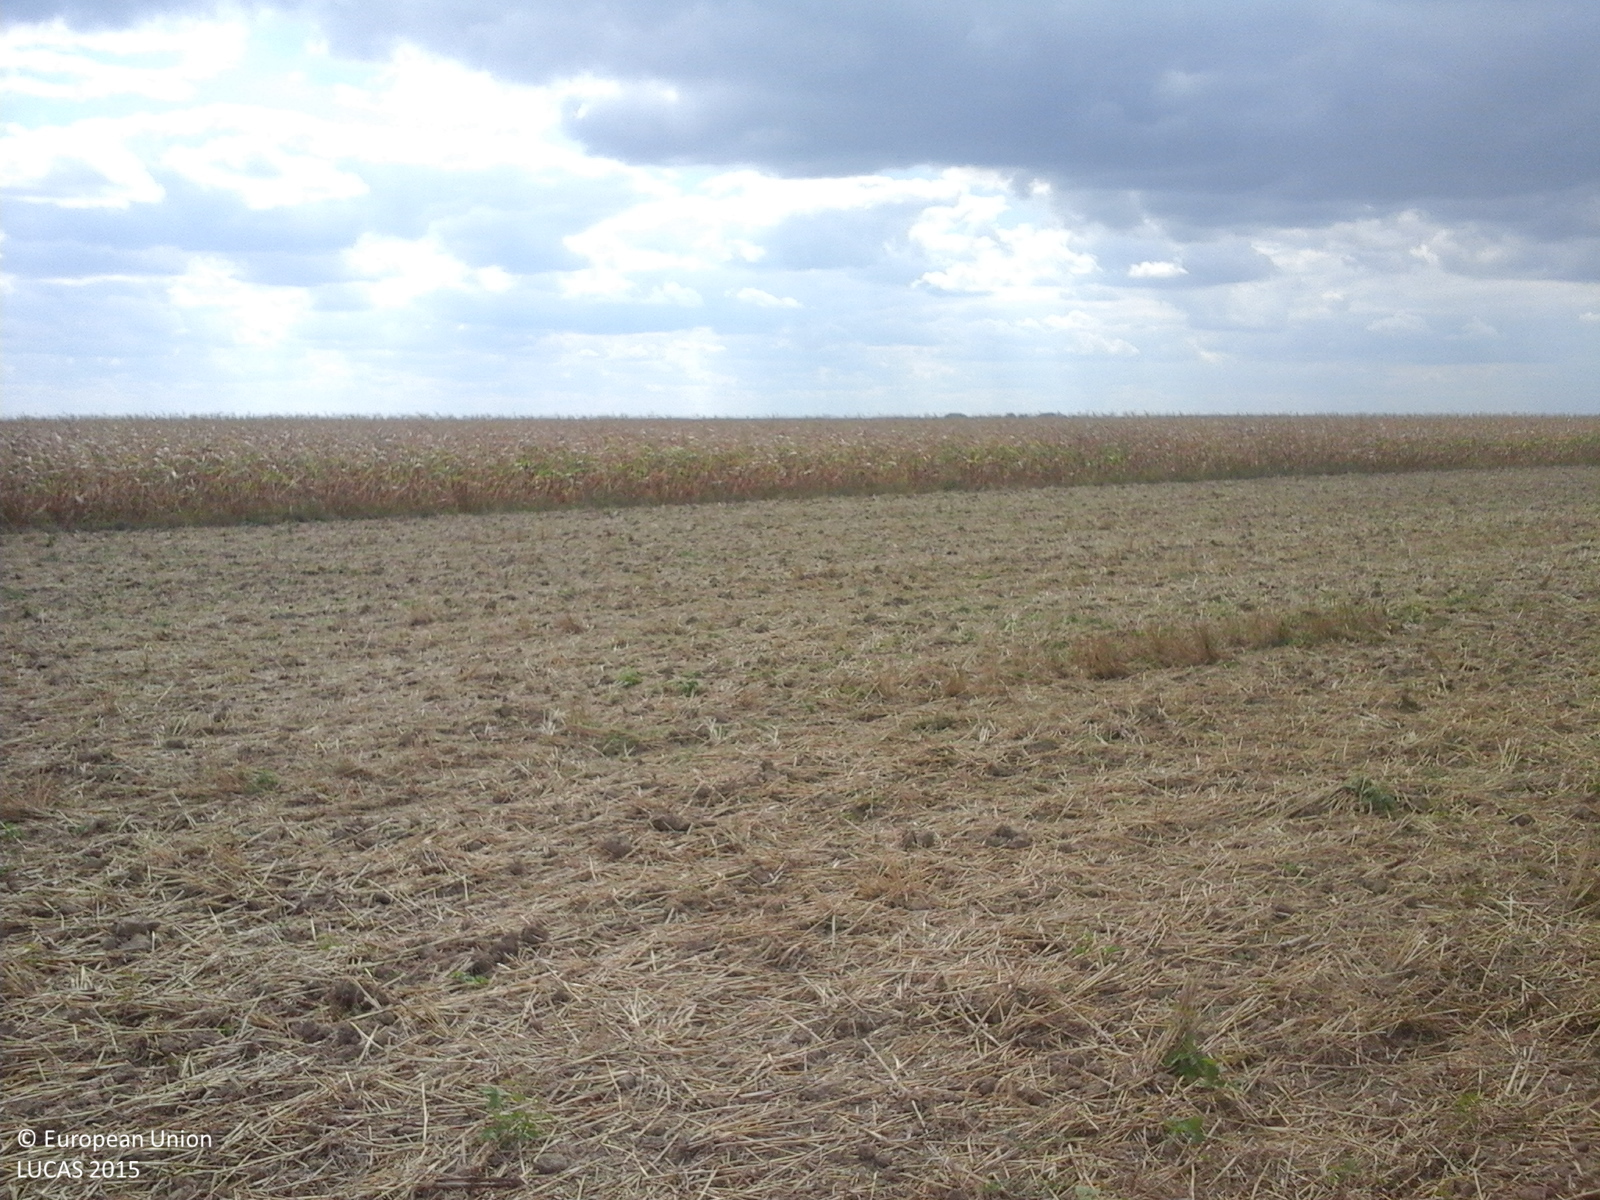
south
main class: Cropland
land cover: Common wheat
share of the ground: 25 - 50 %
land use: Agriculture (excluding fallow land and kitchen gardens)
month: September
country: RO
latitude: 47.8707
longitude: 22.8319
